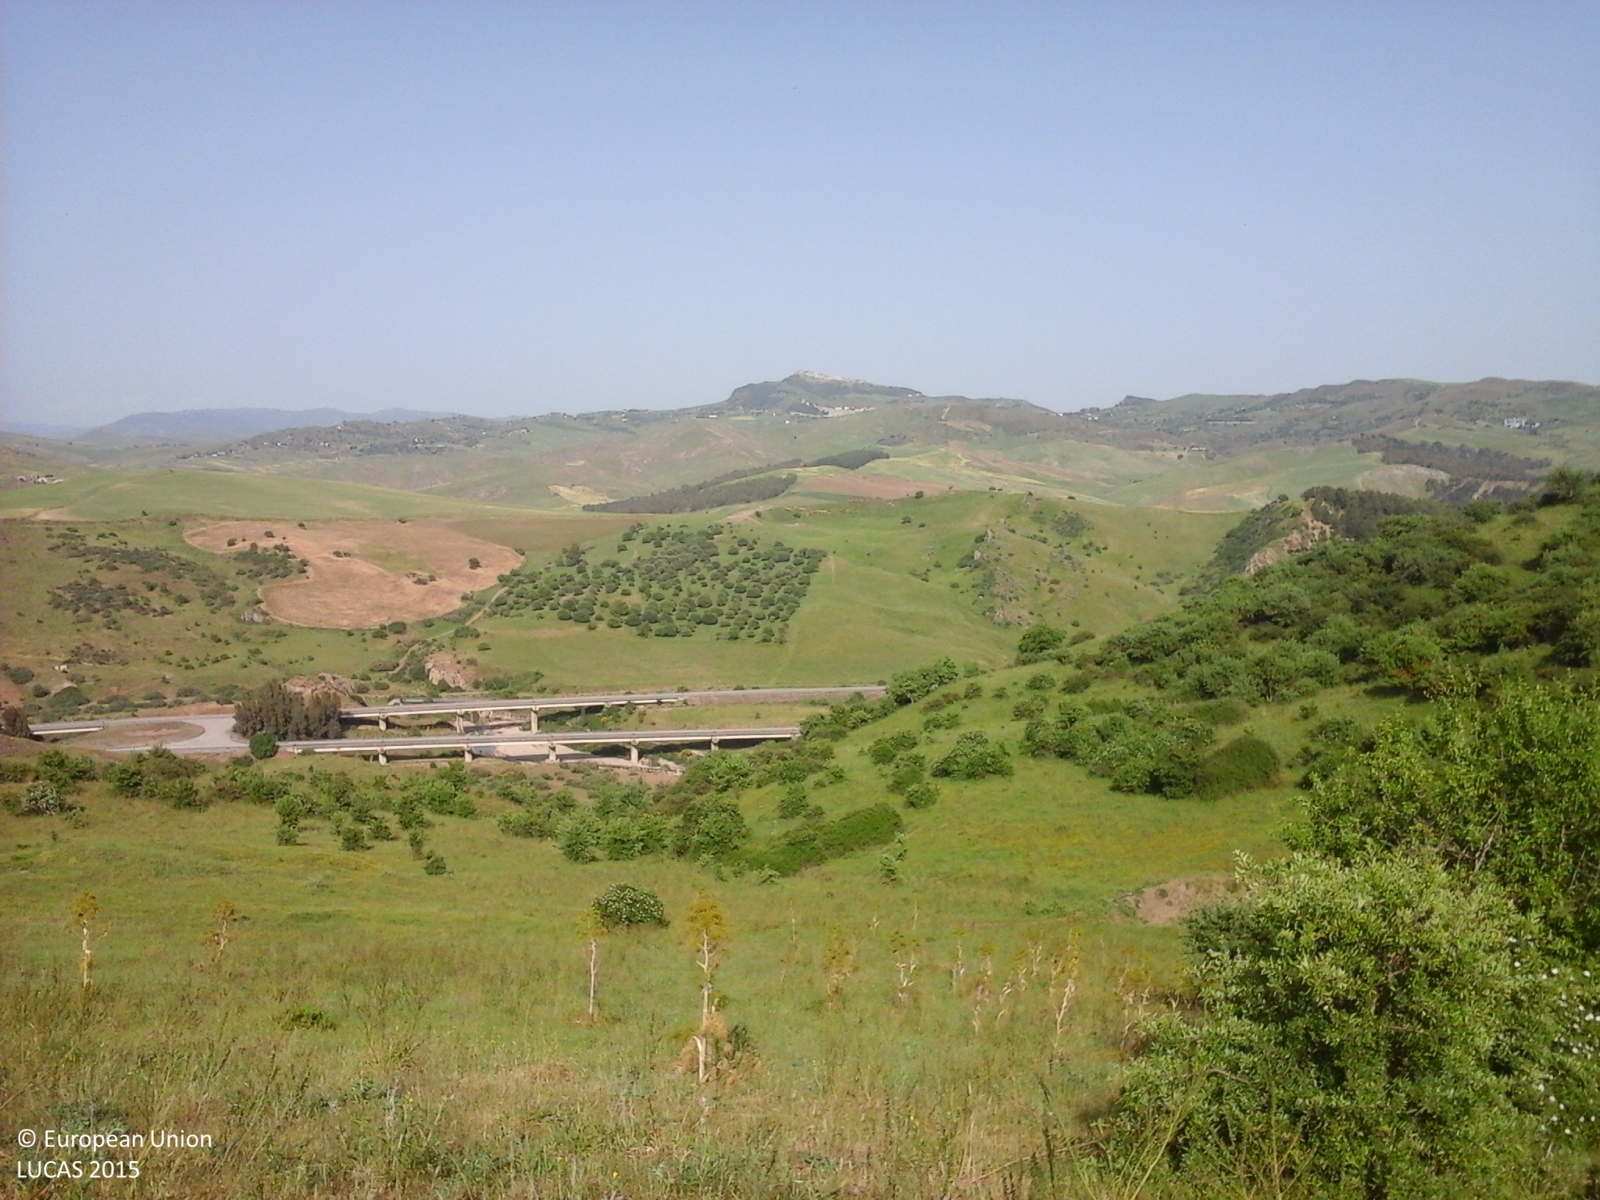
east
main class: Grassland
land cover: Grassland with sparse tree/shrub cover
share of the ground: > 75 %
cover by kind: herbaceous plants 90 %, broadleaved forest trees 5 %, shrubs 5 %
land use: Agriculture (excluding fallow land and kitchen gardens)
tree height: < 5 m
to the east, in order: Grassland with sparse tree/shrub cover; Ditches and canals; Grassland with sparse tree/shrub cover; Shrubland with sparse tree cover
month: May
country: IT
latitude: 37.6979
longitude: 14.0422
